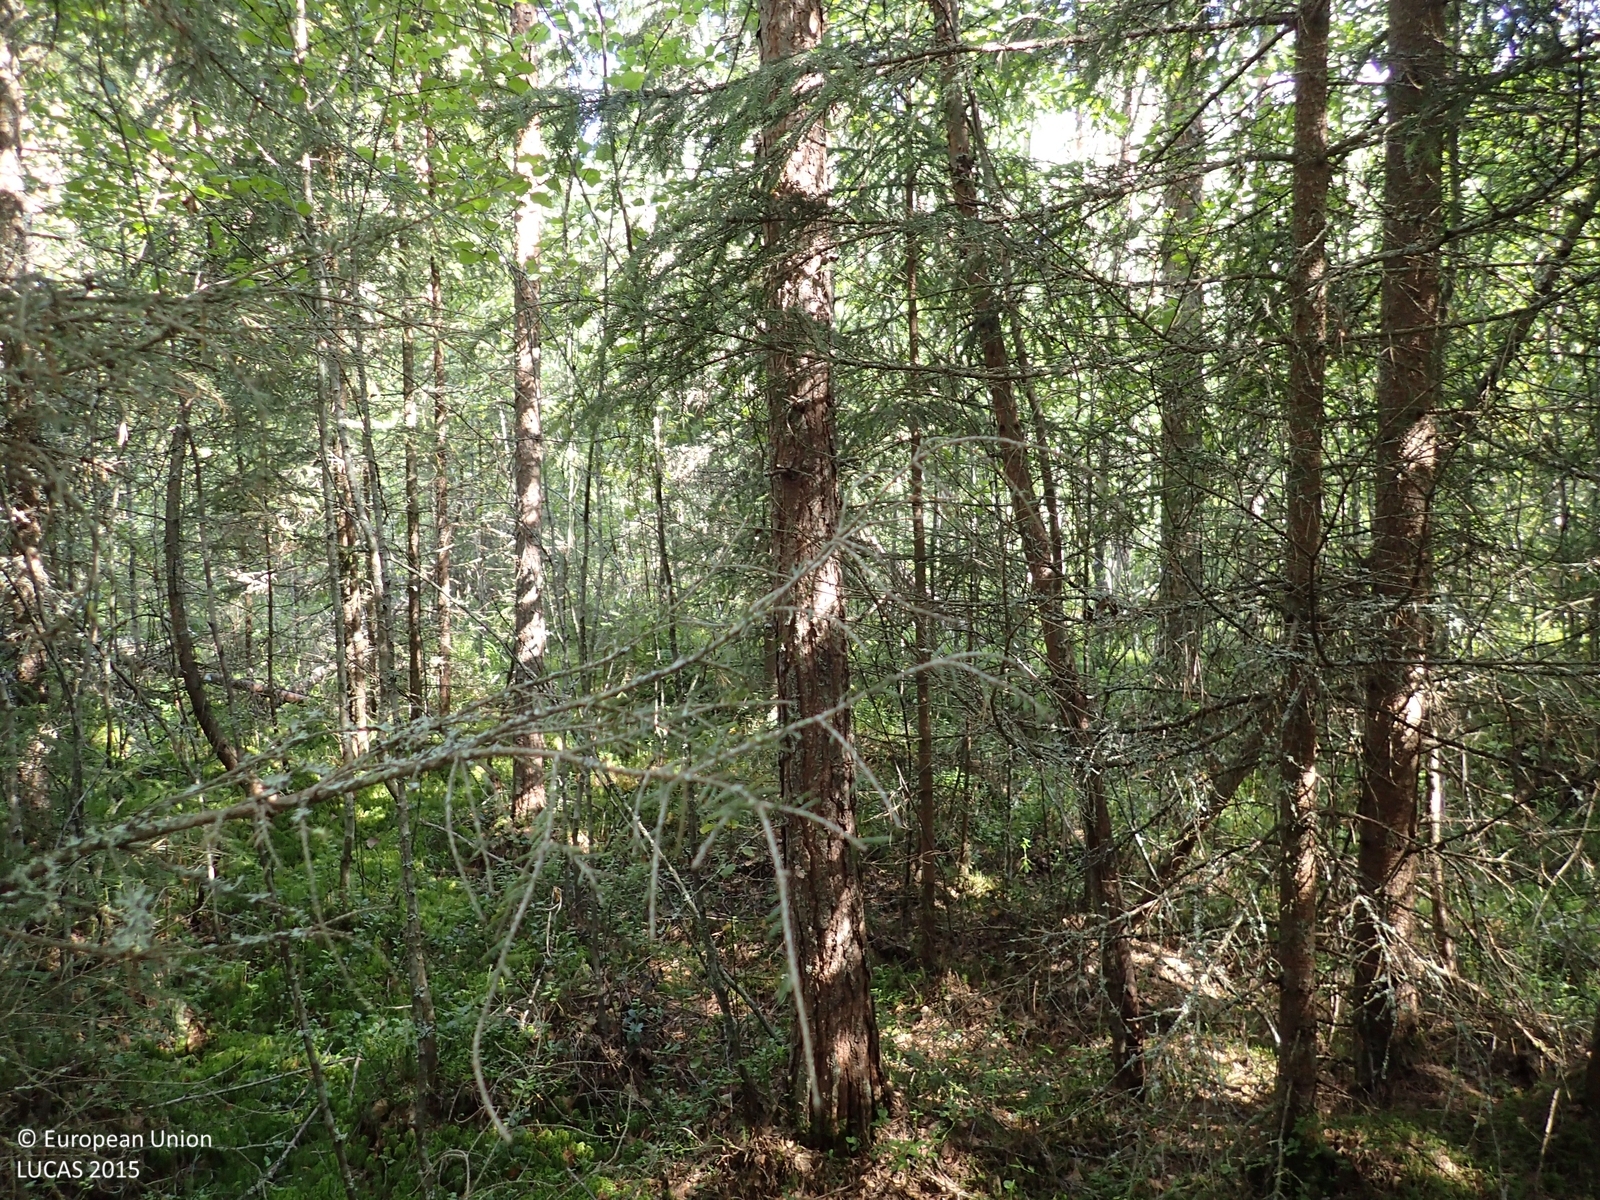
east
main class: Woodland
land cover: Other mixed woodland
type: boreal forest
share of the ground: > 75 %
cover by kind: coniferous forest trees 60 %, broadleaved forest trees 25 %, shrubs 10 %, lichens and mosses 5 %
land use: Forestry
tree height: > 5 m
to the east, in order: Other mixed woodland; Pine dominated mixed woodland; Pine dominated coniferous woodland; Ditches and canals; Pine dominated coniferous woodland
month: August
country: FI
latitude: 62.2809
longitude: 23.0350
